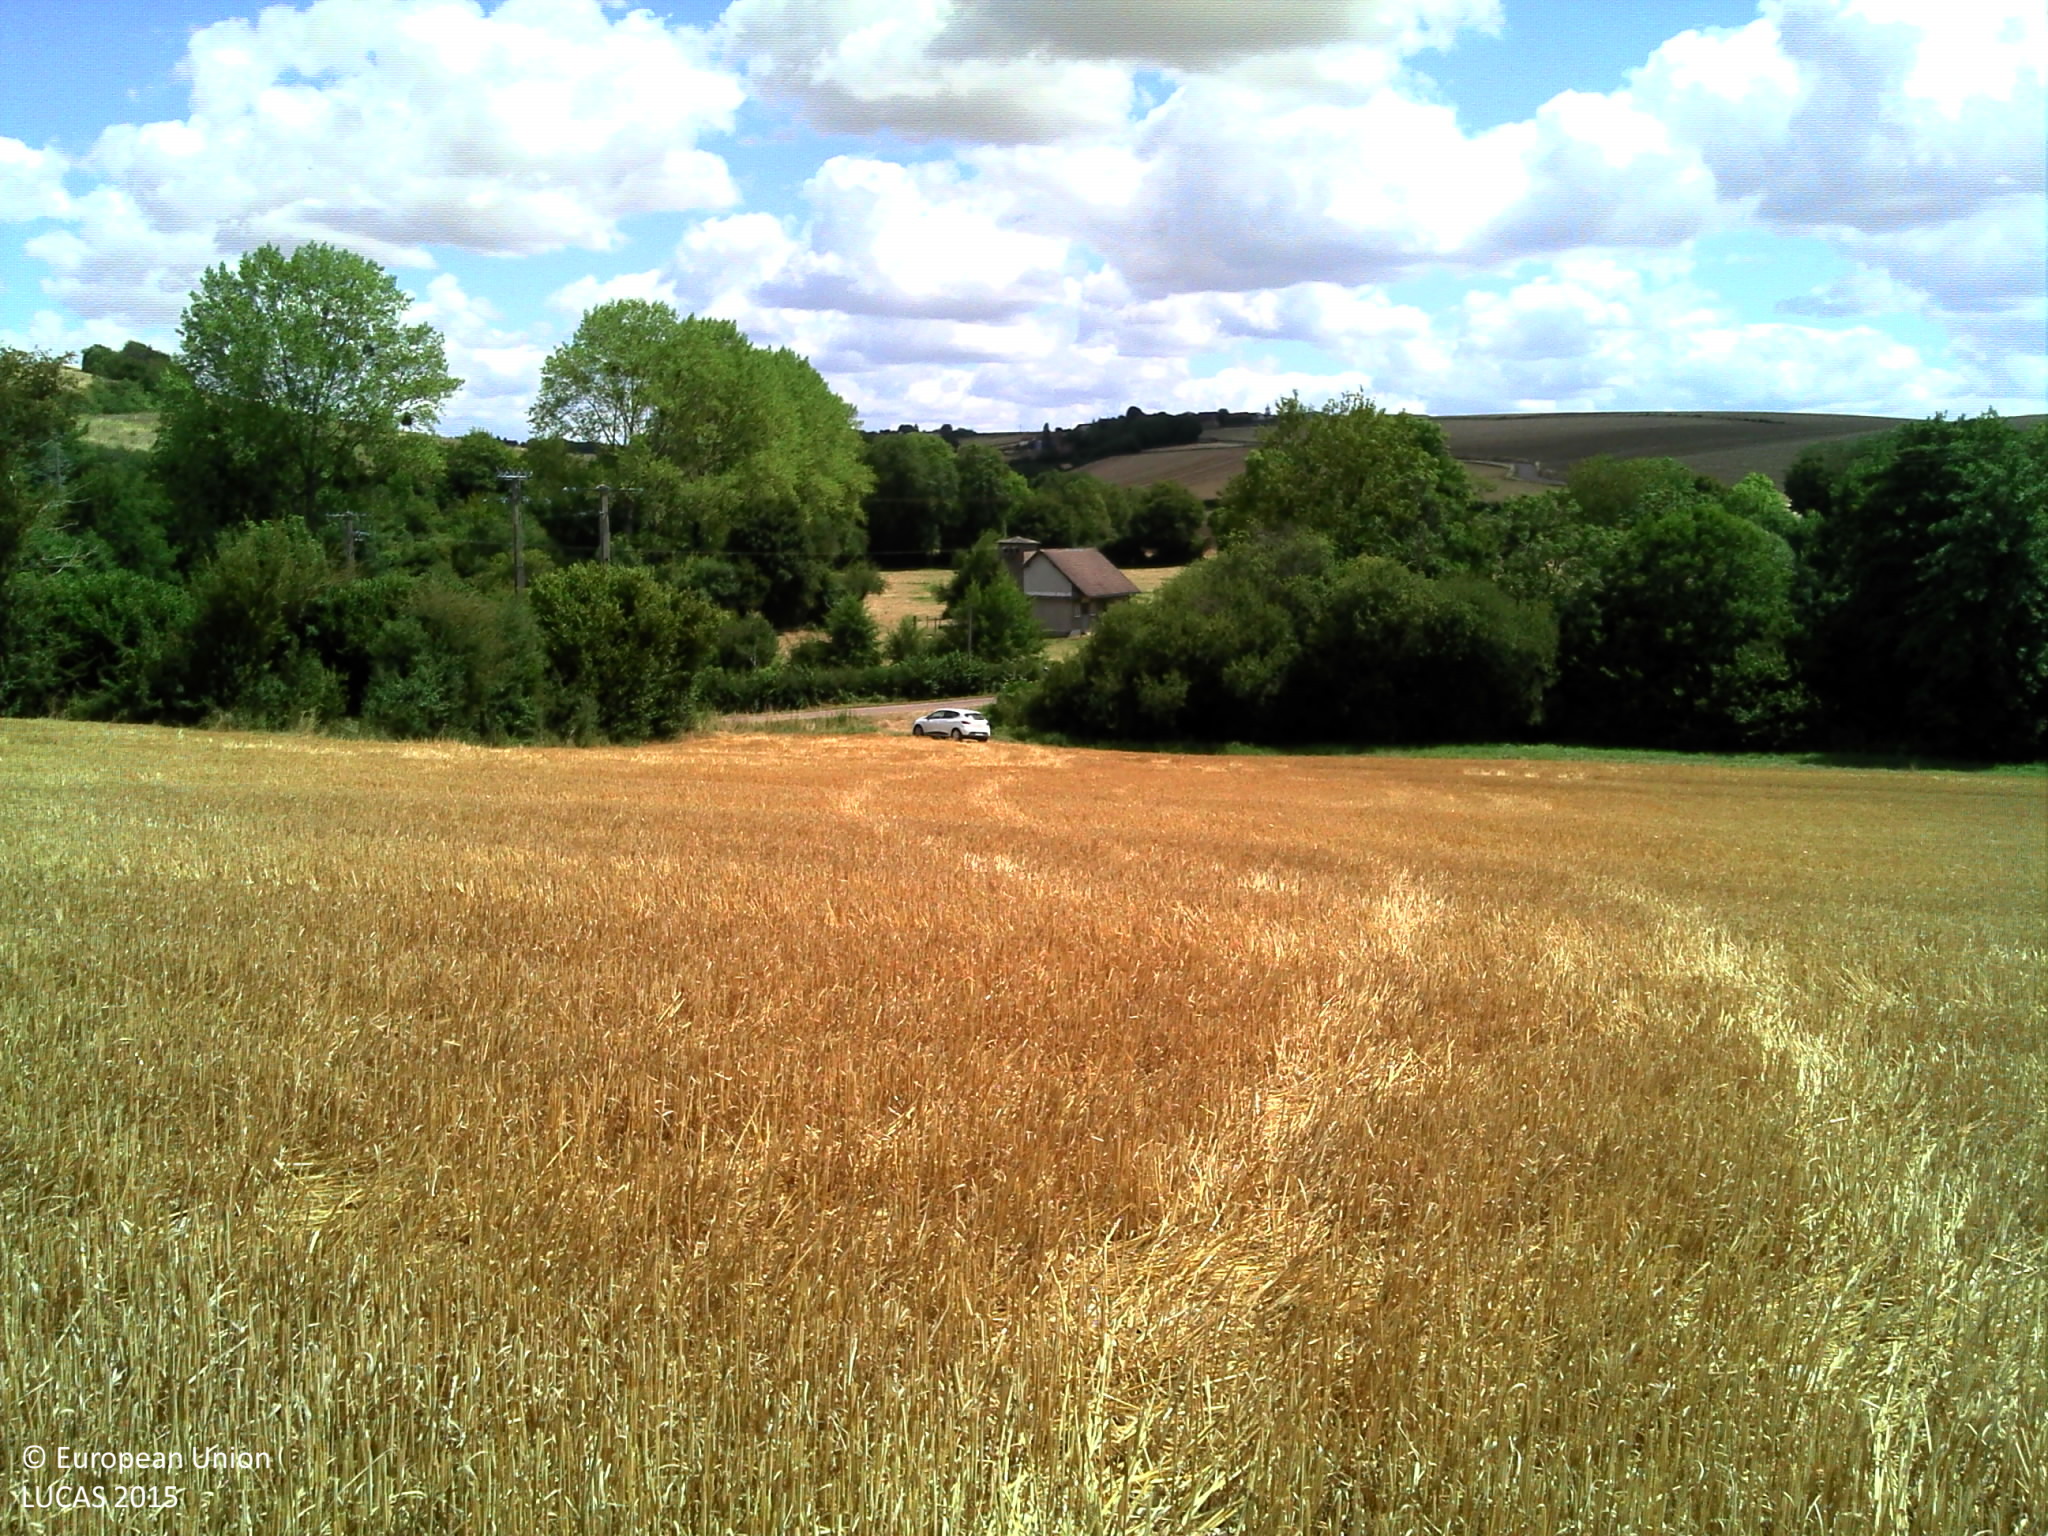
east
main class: Cropland
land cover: Common wheat
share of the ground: > 75 %
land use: Agriculture (excluding fallow land and kitchen gardens)
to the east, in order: Common wheat; Electric lines; Common wheat; Grassland without tree/shrub cover; Paved roads, cycling and walking lanes; Grass margins; Electric lines; Managed hedges; Fences; Grassland without tree/shrub cover; Lines of trees; Rivers and streams; Grassland without tree/shrub cover; Electric lines; Grassland without tree/shrub cover; Artificial constructions in urban areas; Grassland without tree/shrub cover; Single bushes/trees; Rivers and streams; Grassland without tree/shrub cover
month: July
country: FR
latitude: 47.5427
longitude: 3.1792
